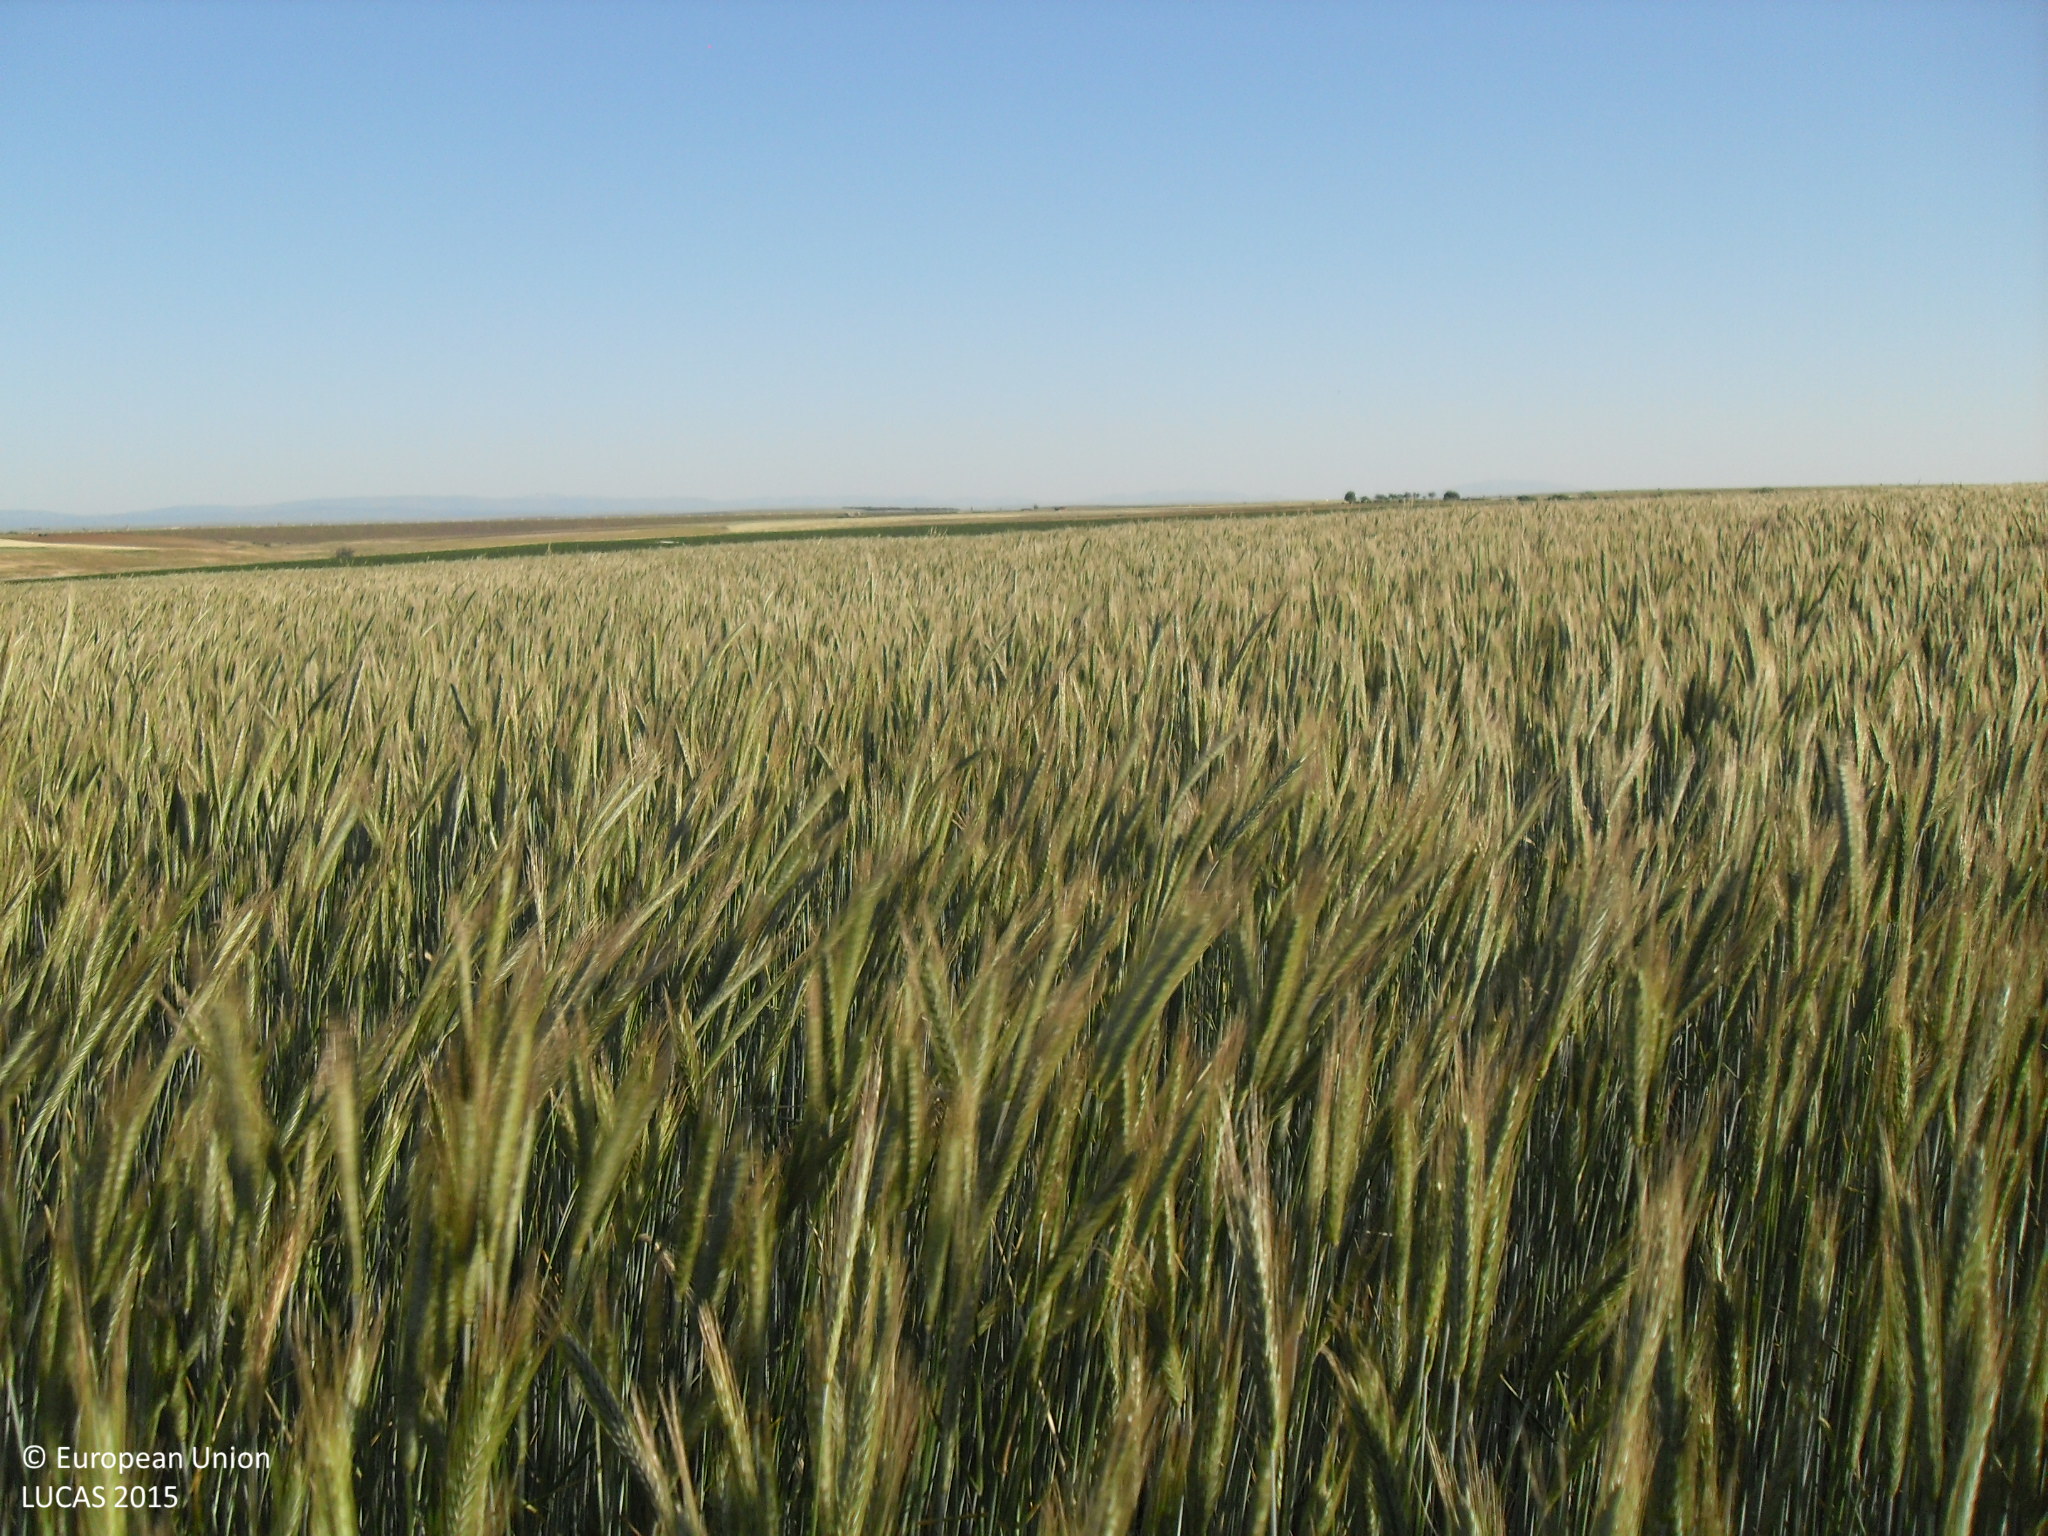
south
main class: Cropland
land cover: Rye
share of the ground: > 75 %
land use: Agriculture (excluding fallow land and kitchen gardens)
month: May
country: ES
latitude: 41.0239
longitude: -5.3059
